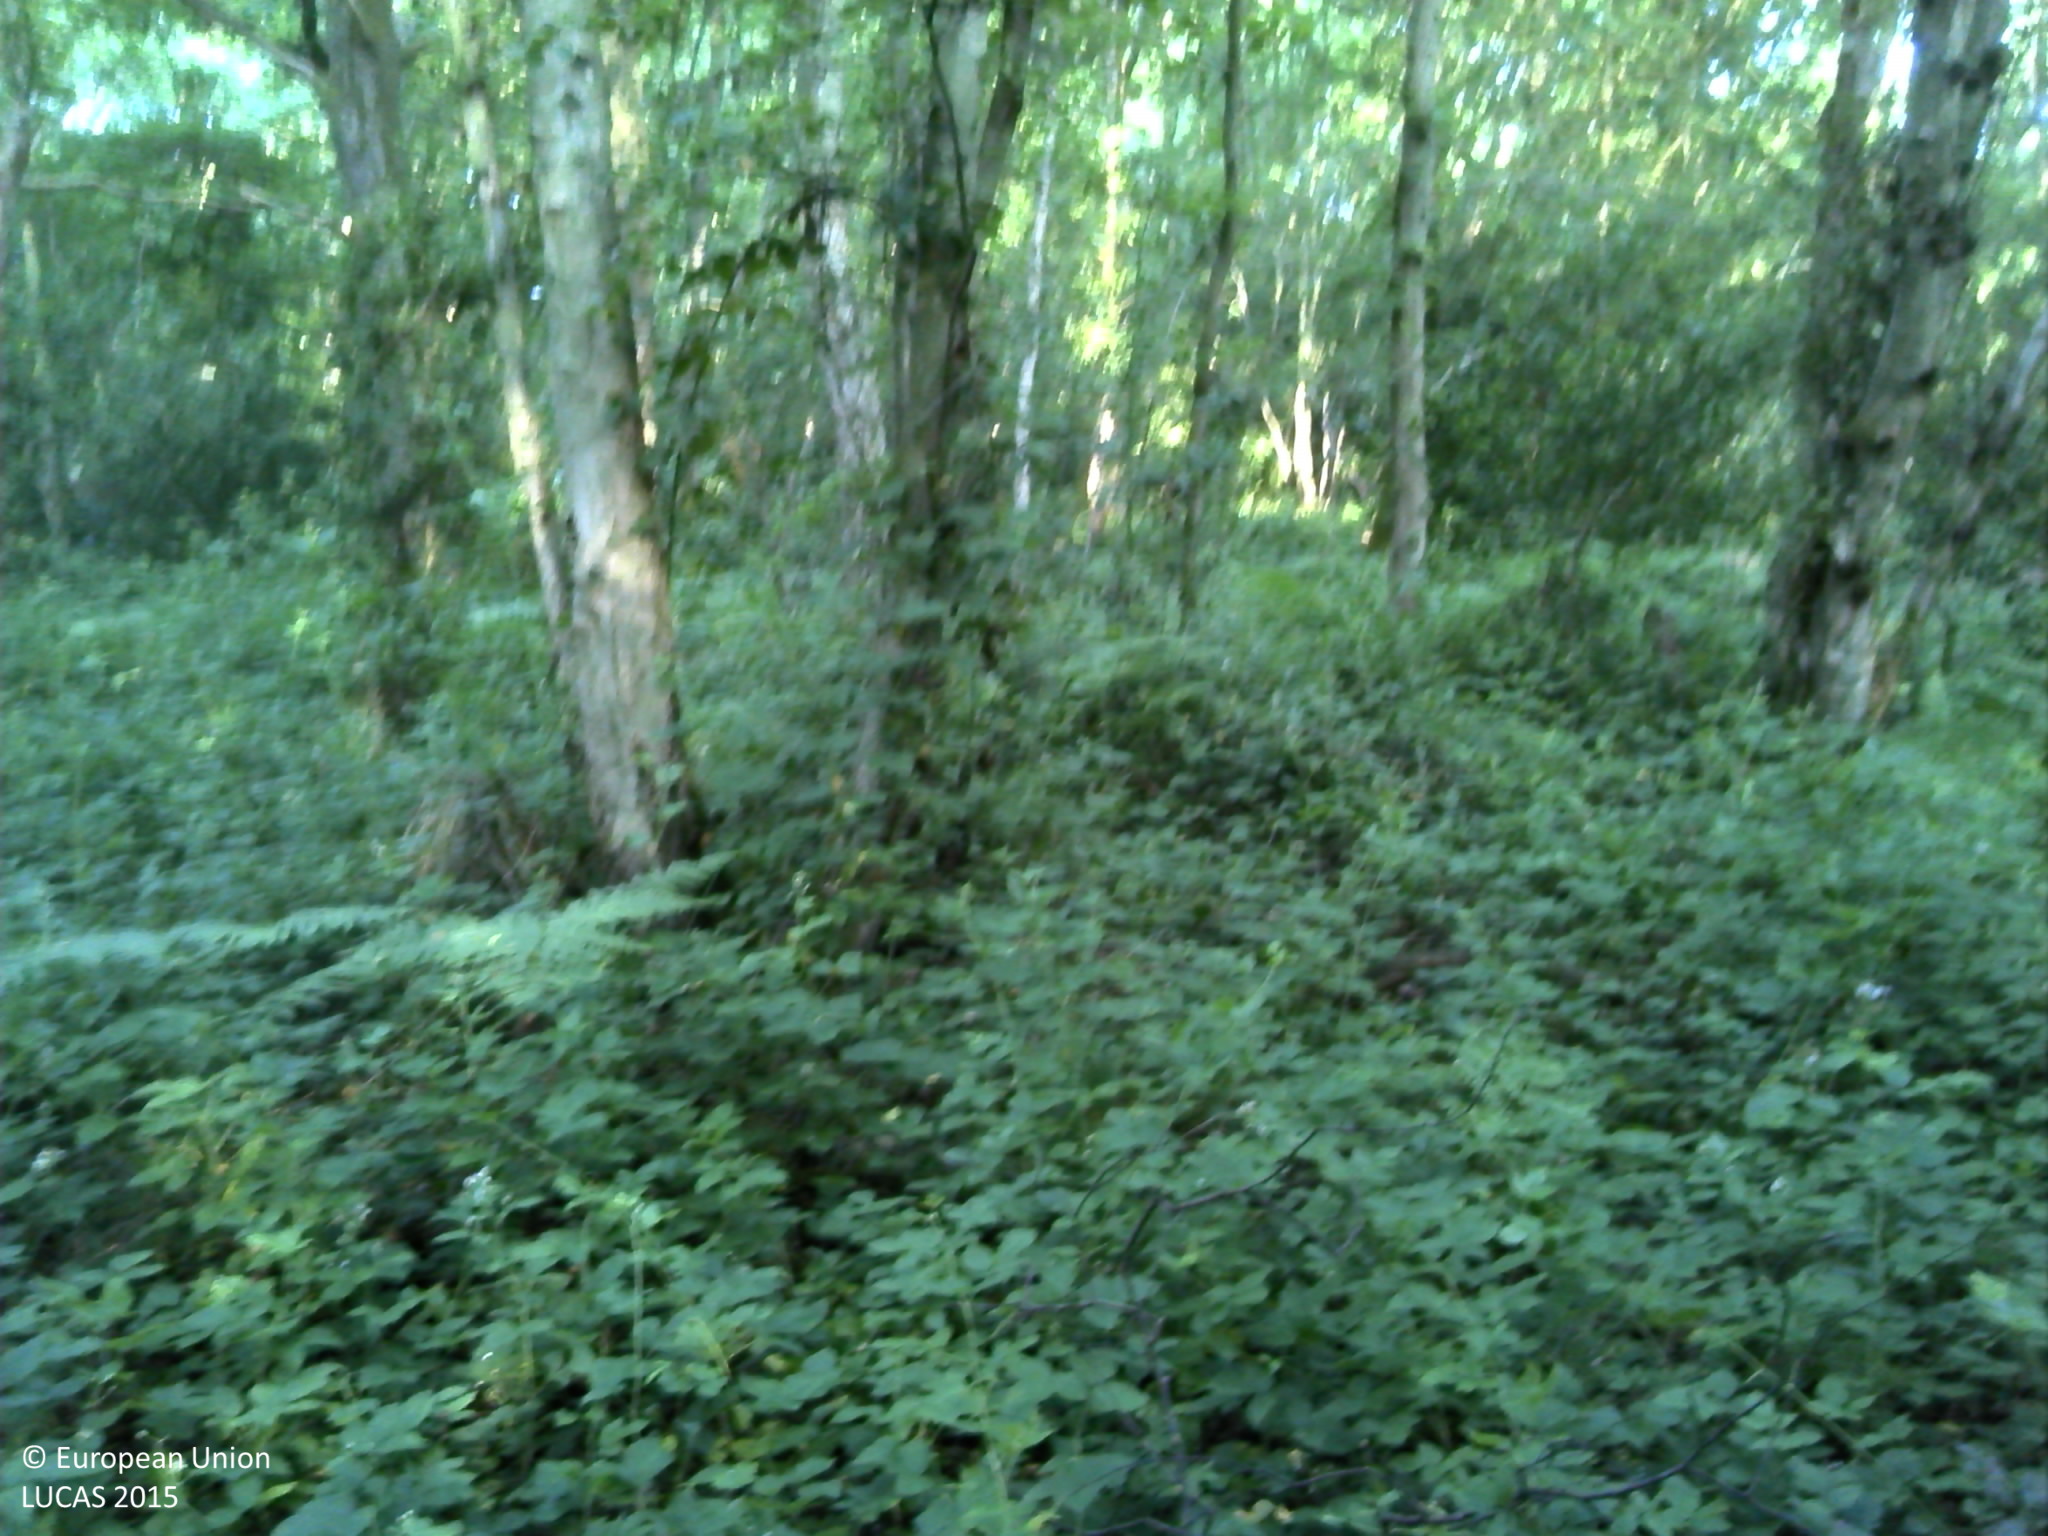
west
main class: Woodland
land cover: Broadleaved woodland
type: acidophilous oak and oak-birch forest
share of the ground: > 75 %
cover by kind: broadleaved forest trees 100 %
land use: Forestry
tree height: > 5 m
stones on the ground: 25 - 50 %
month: July
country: FR
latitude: 49.3579
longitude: 1.2370
